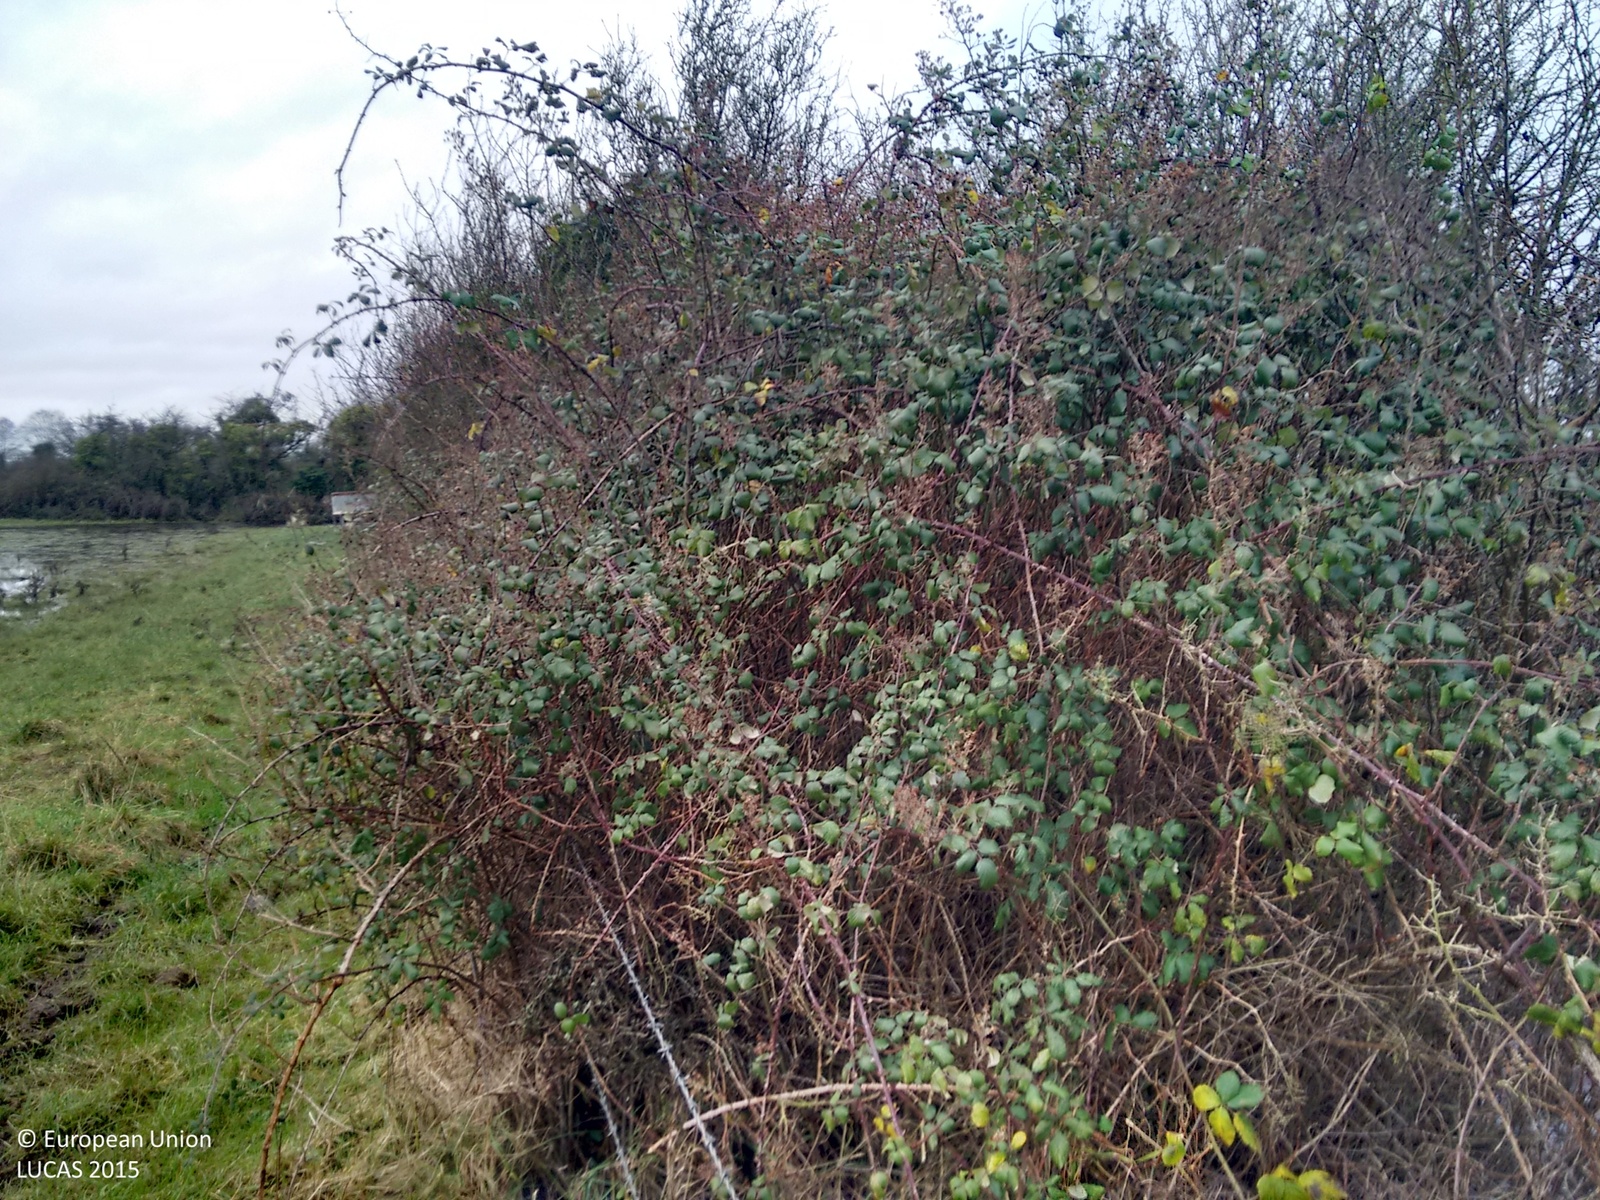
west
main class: Grassland
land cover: Grassland without tree/shrub cover
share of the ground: 50 - 75 %
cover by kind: herbaceous plants 95 %
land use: Agriculture (excluding fallow land and kitchen gardens)
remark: Temporary flooded
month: December
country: IE
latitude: 53.3114
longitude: -7.8662
